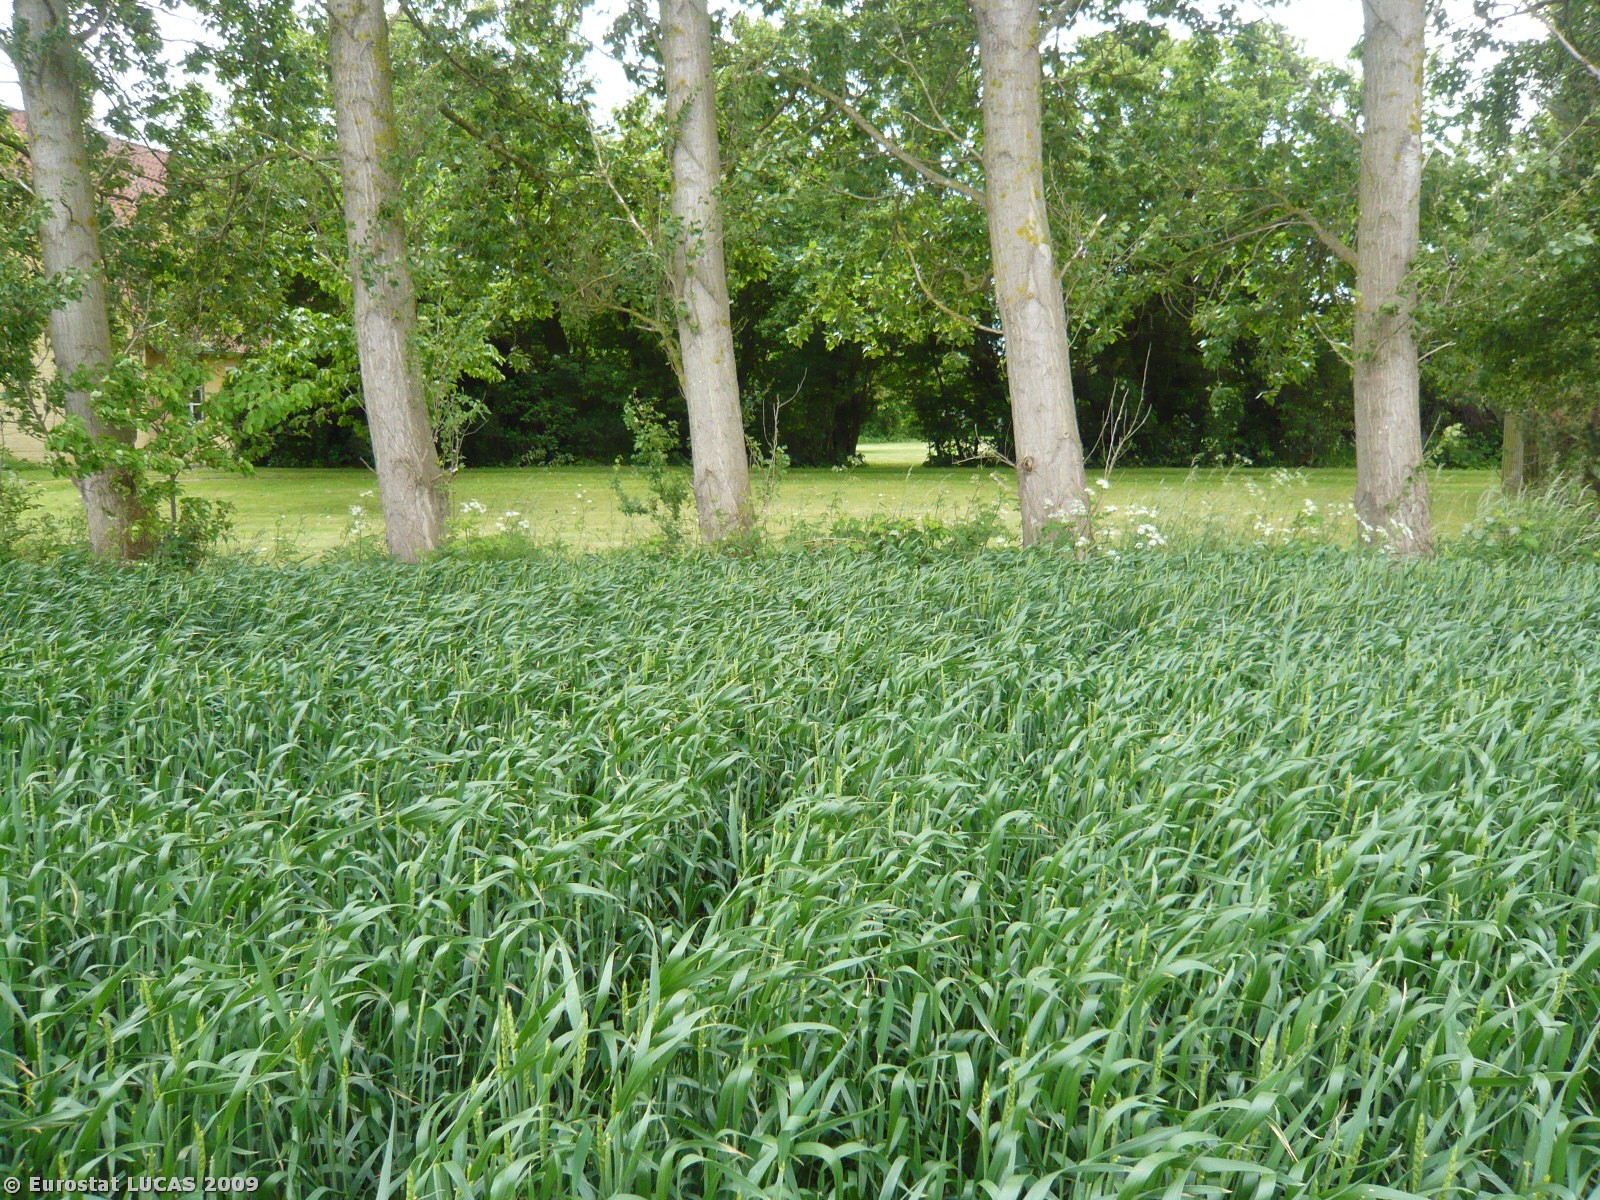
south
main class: Cropland
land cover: Common wheat
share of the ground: > 75 %
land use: Agriculture (excluding fallow land and kitchen gardens)
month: June
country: DK
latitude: 54.7168
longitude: 11.9393
